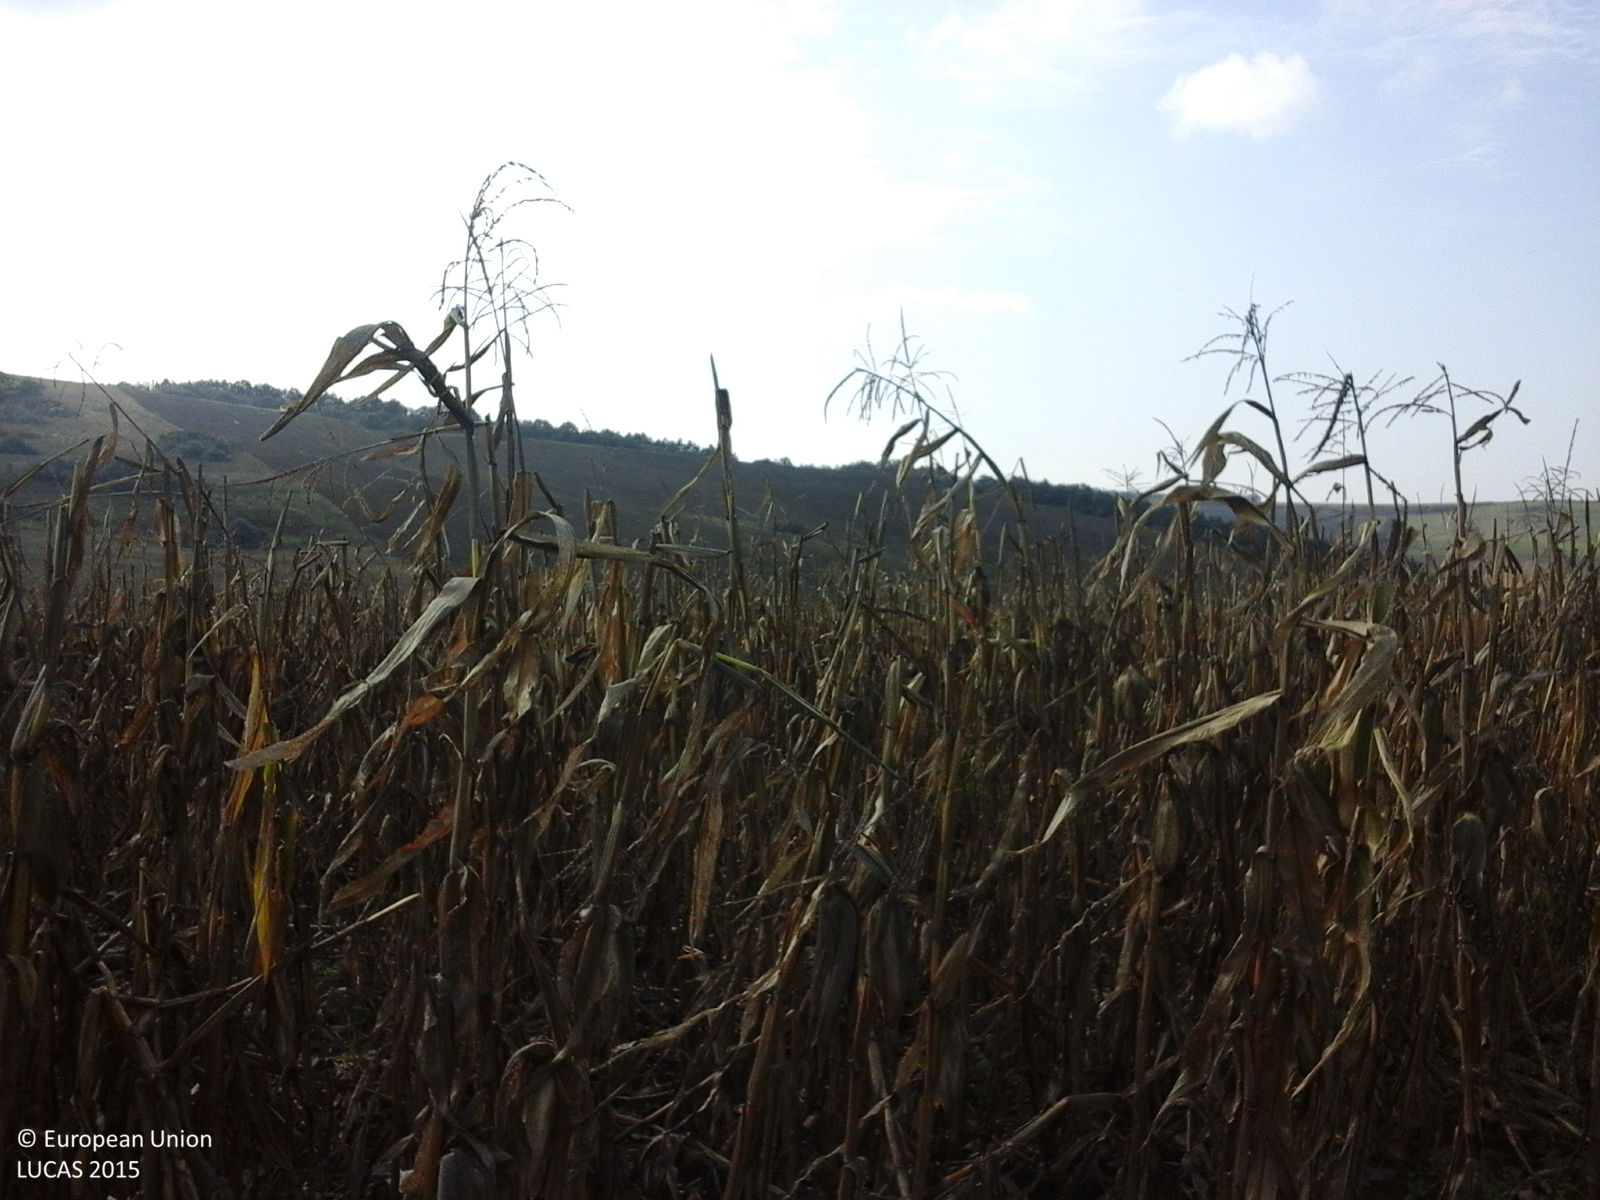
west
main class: Cropland
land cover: Maize
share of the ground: > 75 %
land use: Agriculture (excluding fallow land and kitchen gardens)
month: October
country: RO
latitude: 46.4045
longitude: 24.3258
